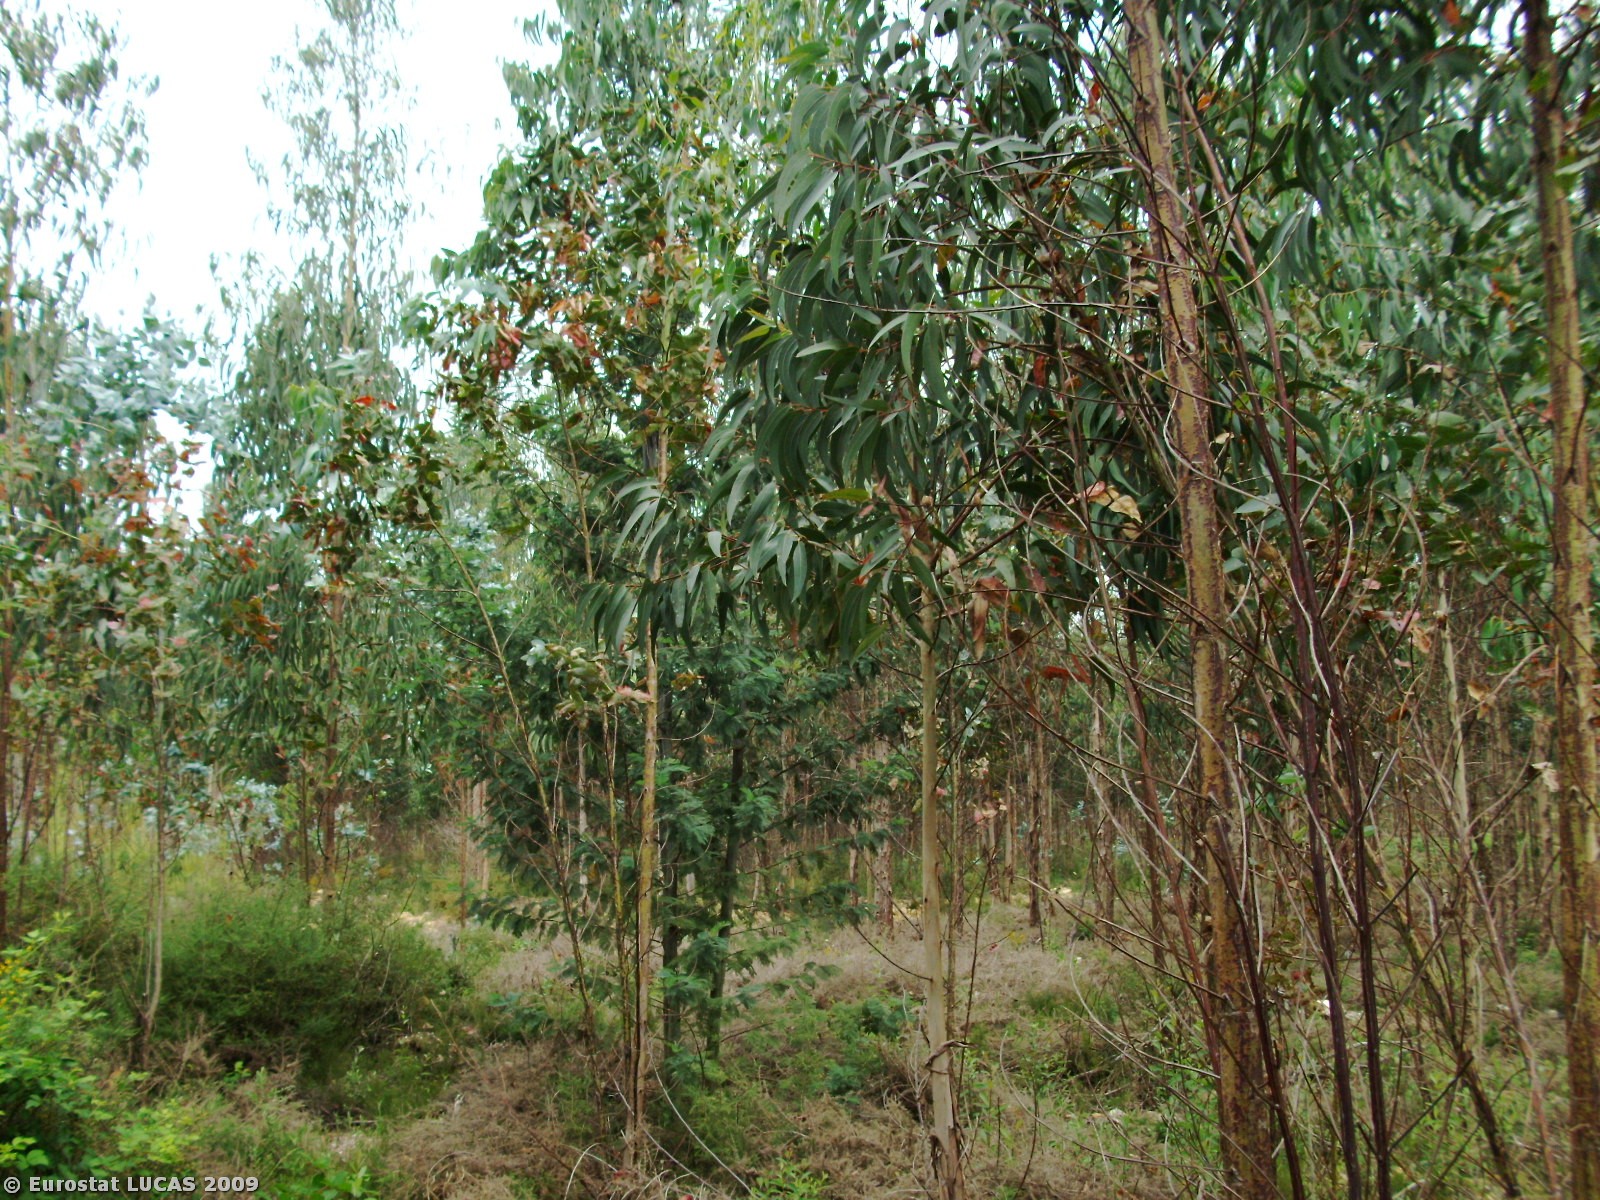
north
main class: Woodland
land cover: Broadleaved woodland
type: plantations and self-sown exotic forest
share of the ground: > 75 %
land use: Forestry
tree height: > 5 m
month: May
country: PT
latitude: 40.5134
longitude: -8.3687
